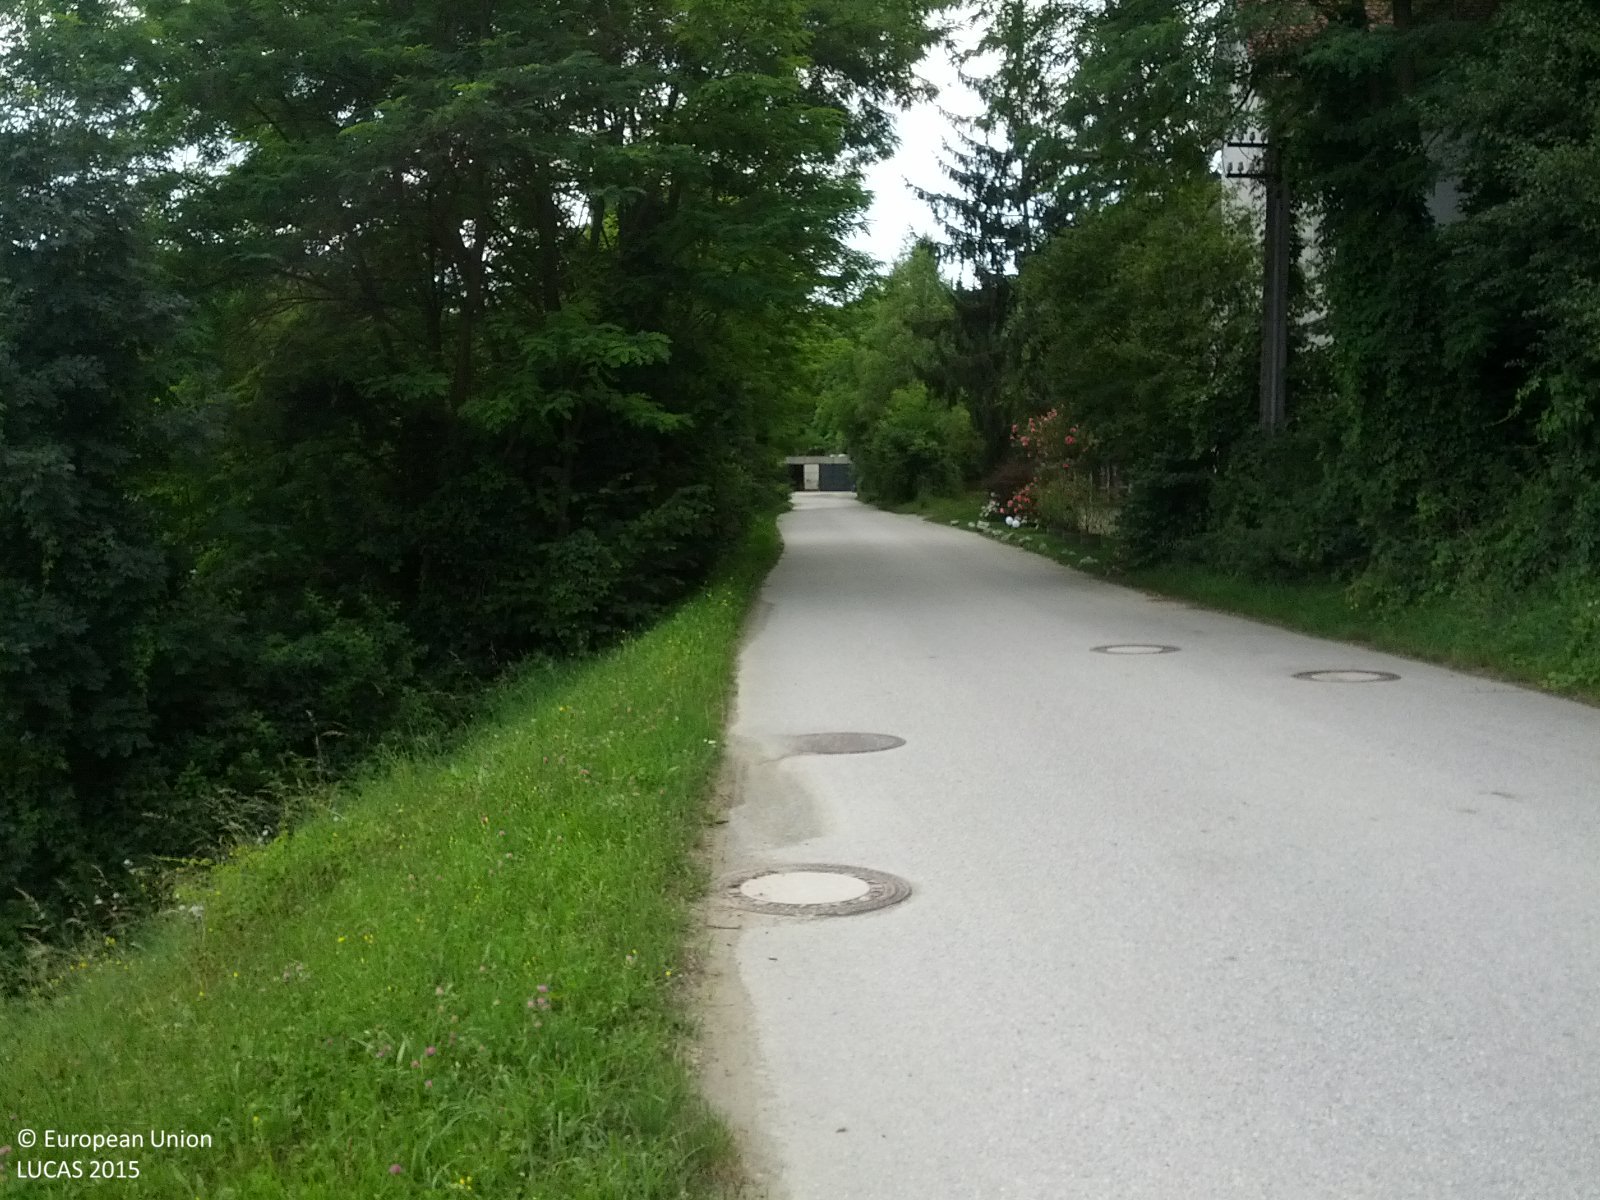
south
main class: Grassland
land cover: Grassland without tree/shrub cover
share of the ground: > 75 %
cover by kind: herbaceous plants 100 %
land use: Road transport
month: July
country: AT
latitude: 47.2262
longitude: 16.3816
